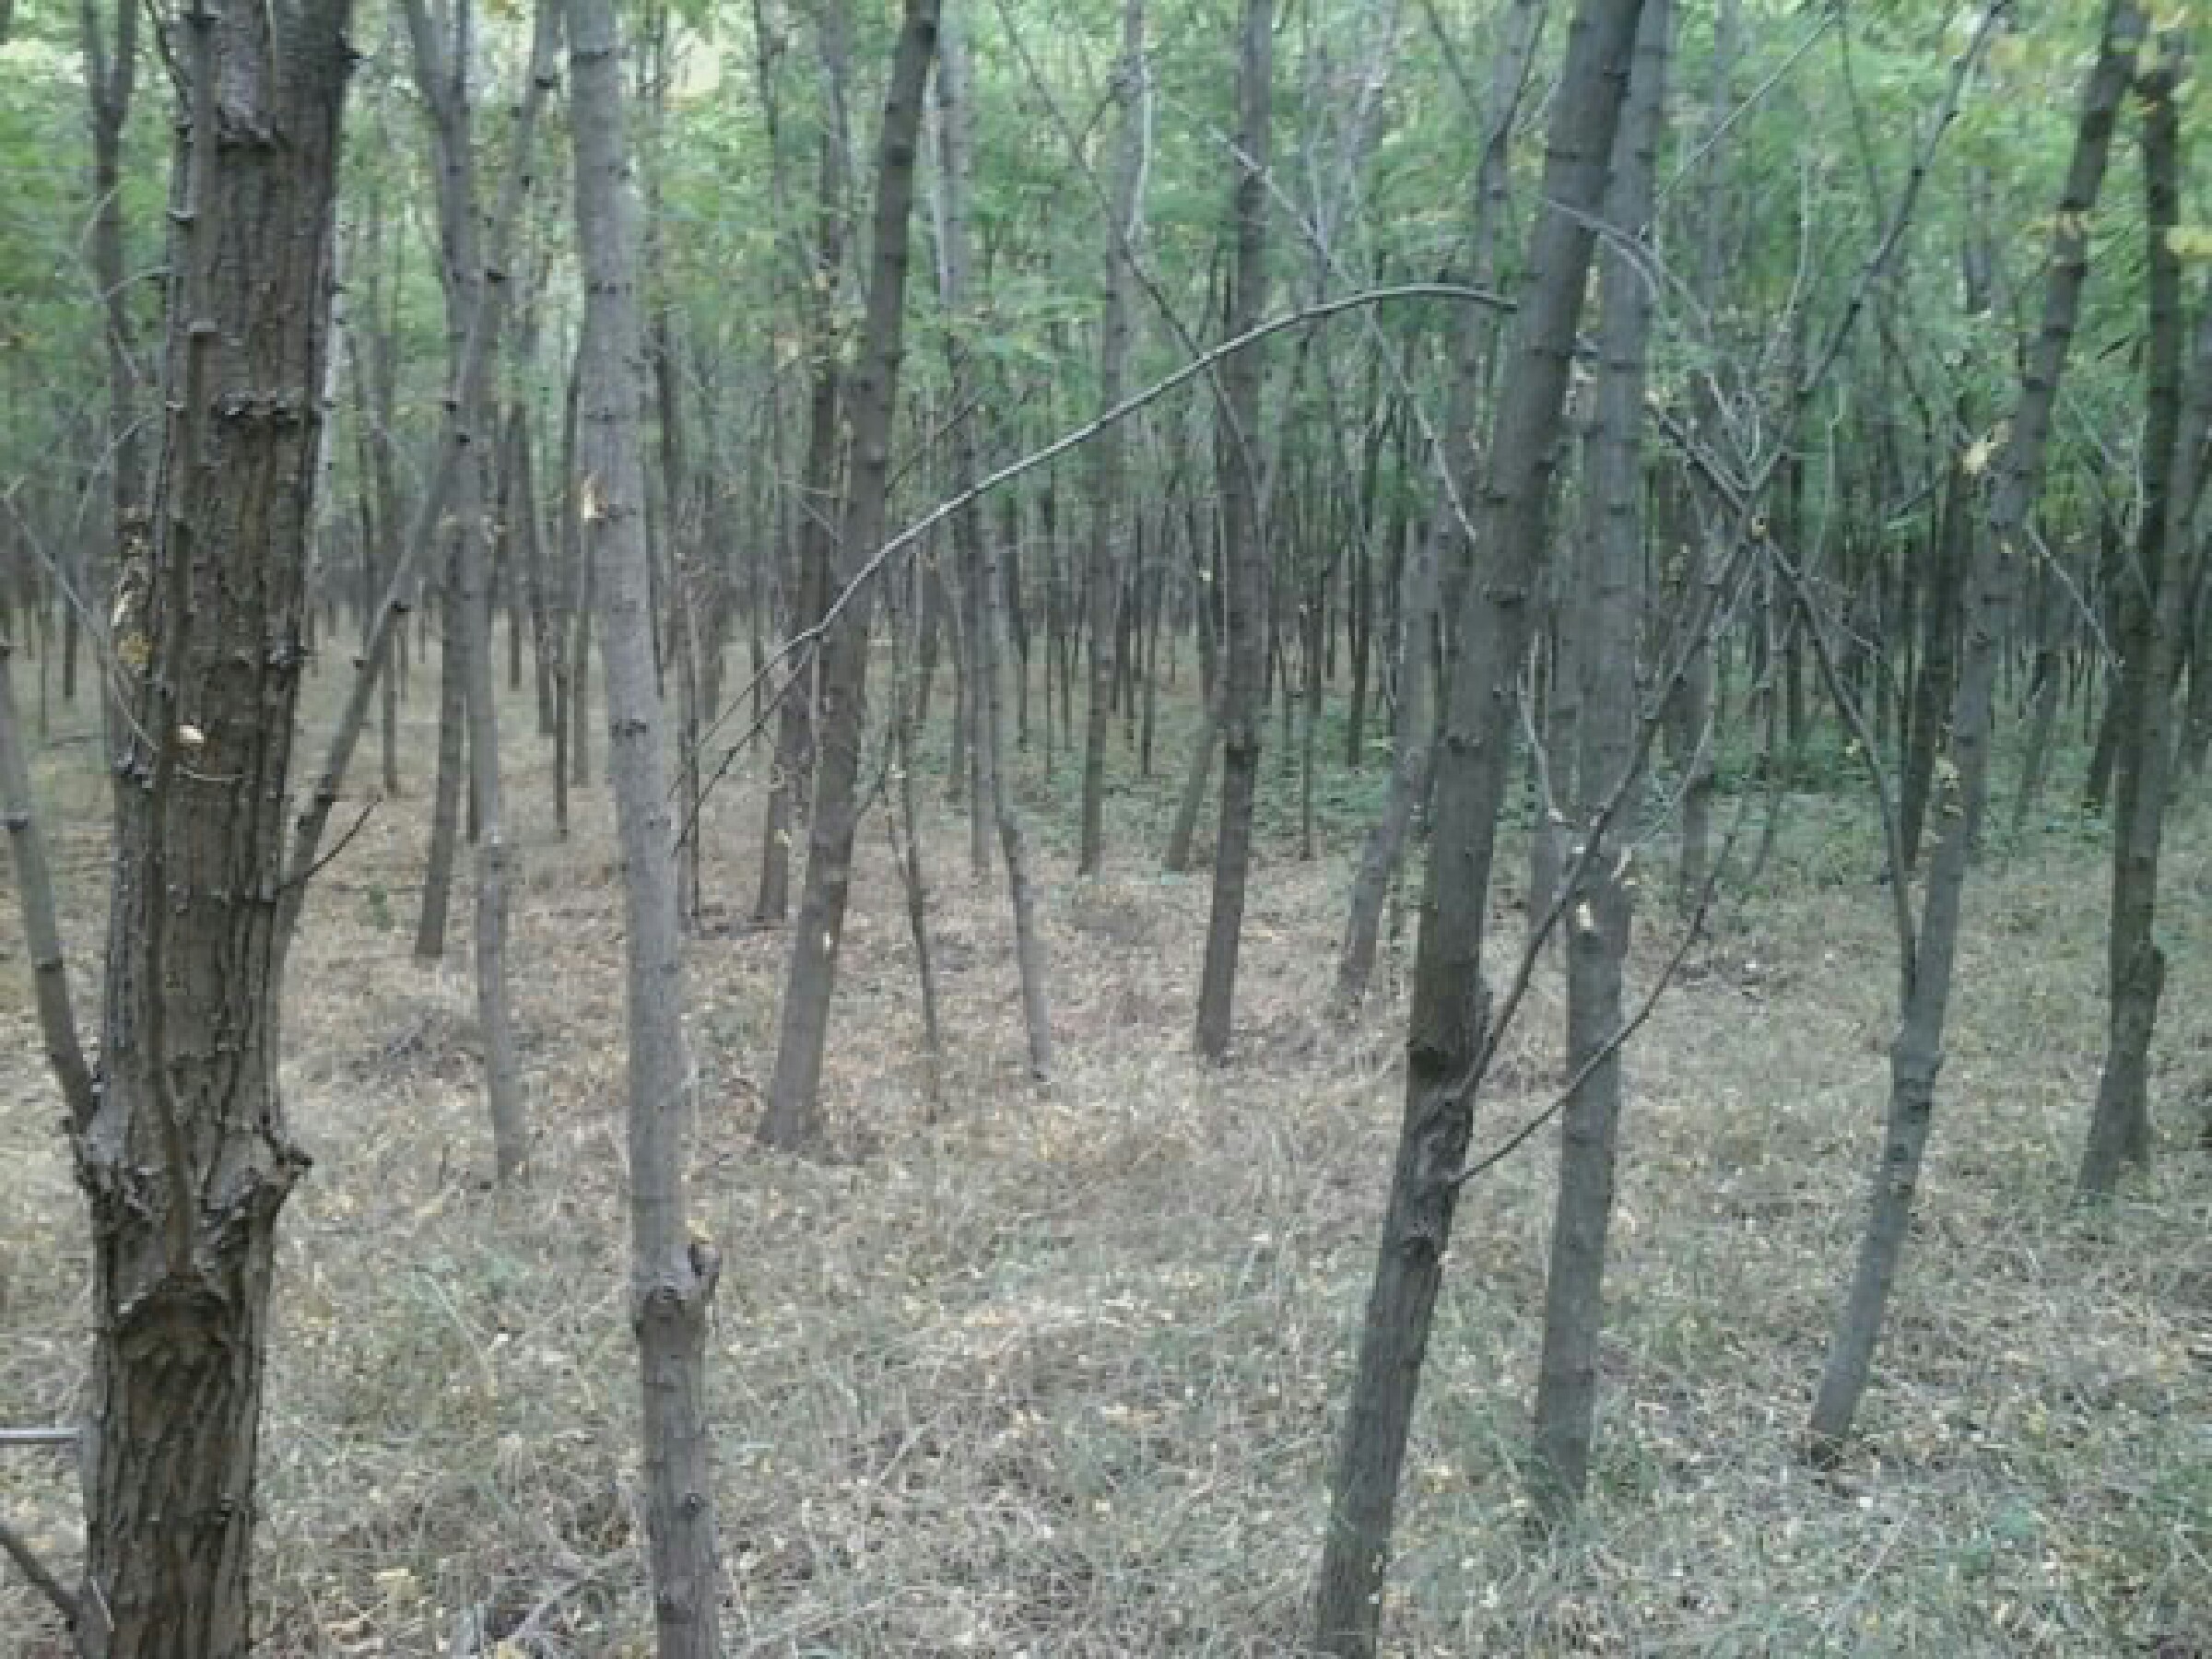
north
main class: Woodland
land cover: Broadleaved woodland
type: exotic forest
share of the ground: > 75 %
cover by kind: broadleaved forest trees 100 %
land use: Forestry
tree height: > 5 m
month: July
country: HU
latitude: 47.8448
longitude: 19.3351
